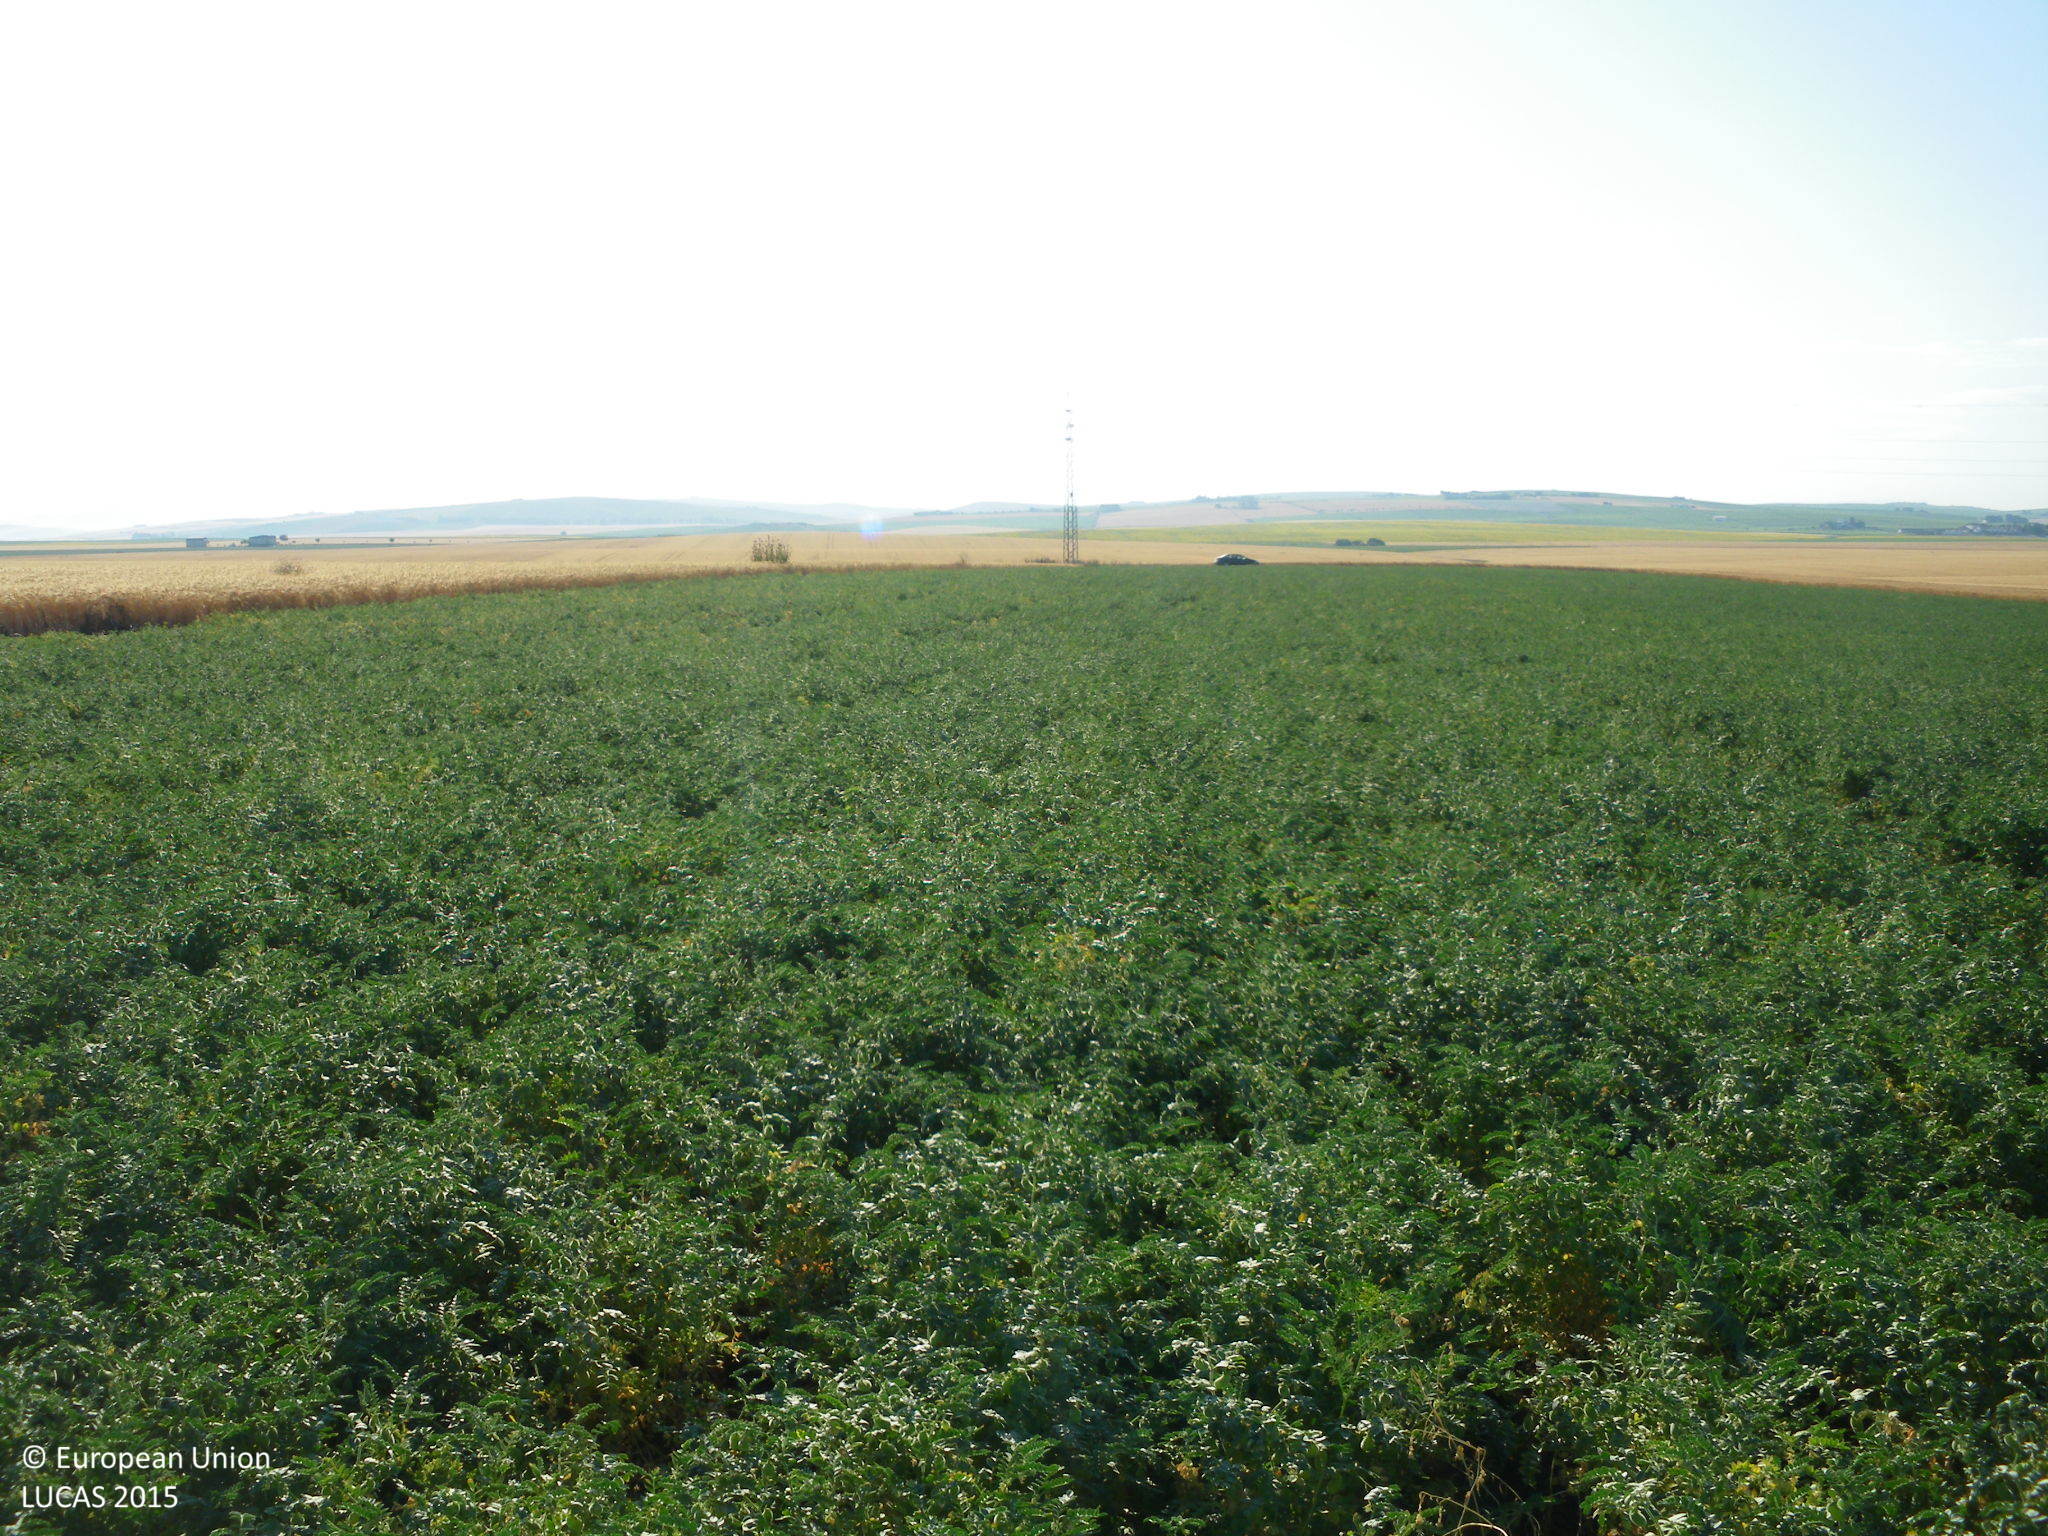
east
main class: Cropland
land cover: Dry pulses
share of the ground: > 75 %
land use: Agriculture (excluding fallow land and kitchen gardens)
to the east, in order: Dry pulses; Common wheat; Electric lines; Grassland without tree/shrub cover; Tracks; Grass margins; Common wheat
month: May
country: ES
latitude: 36.7252
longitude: -6.2617
